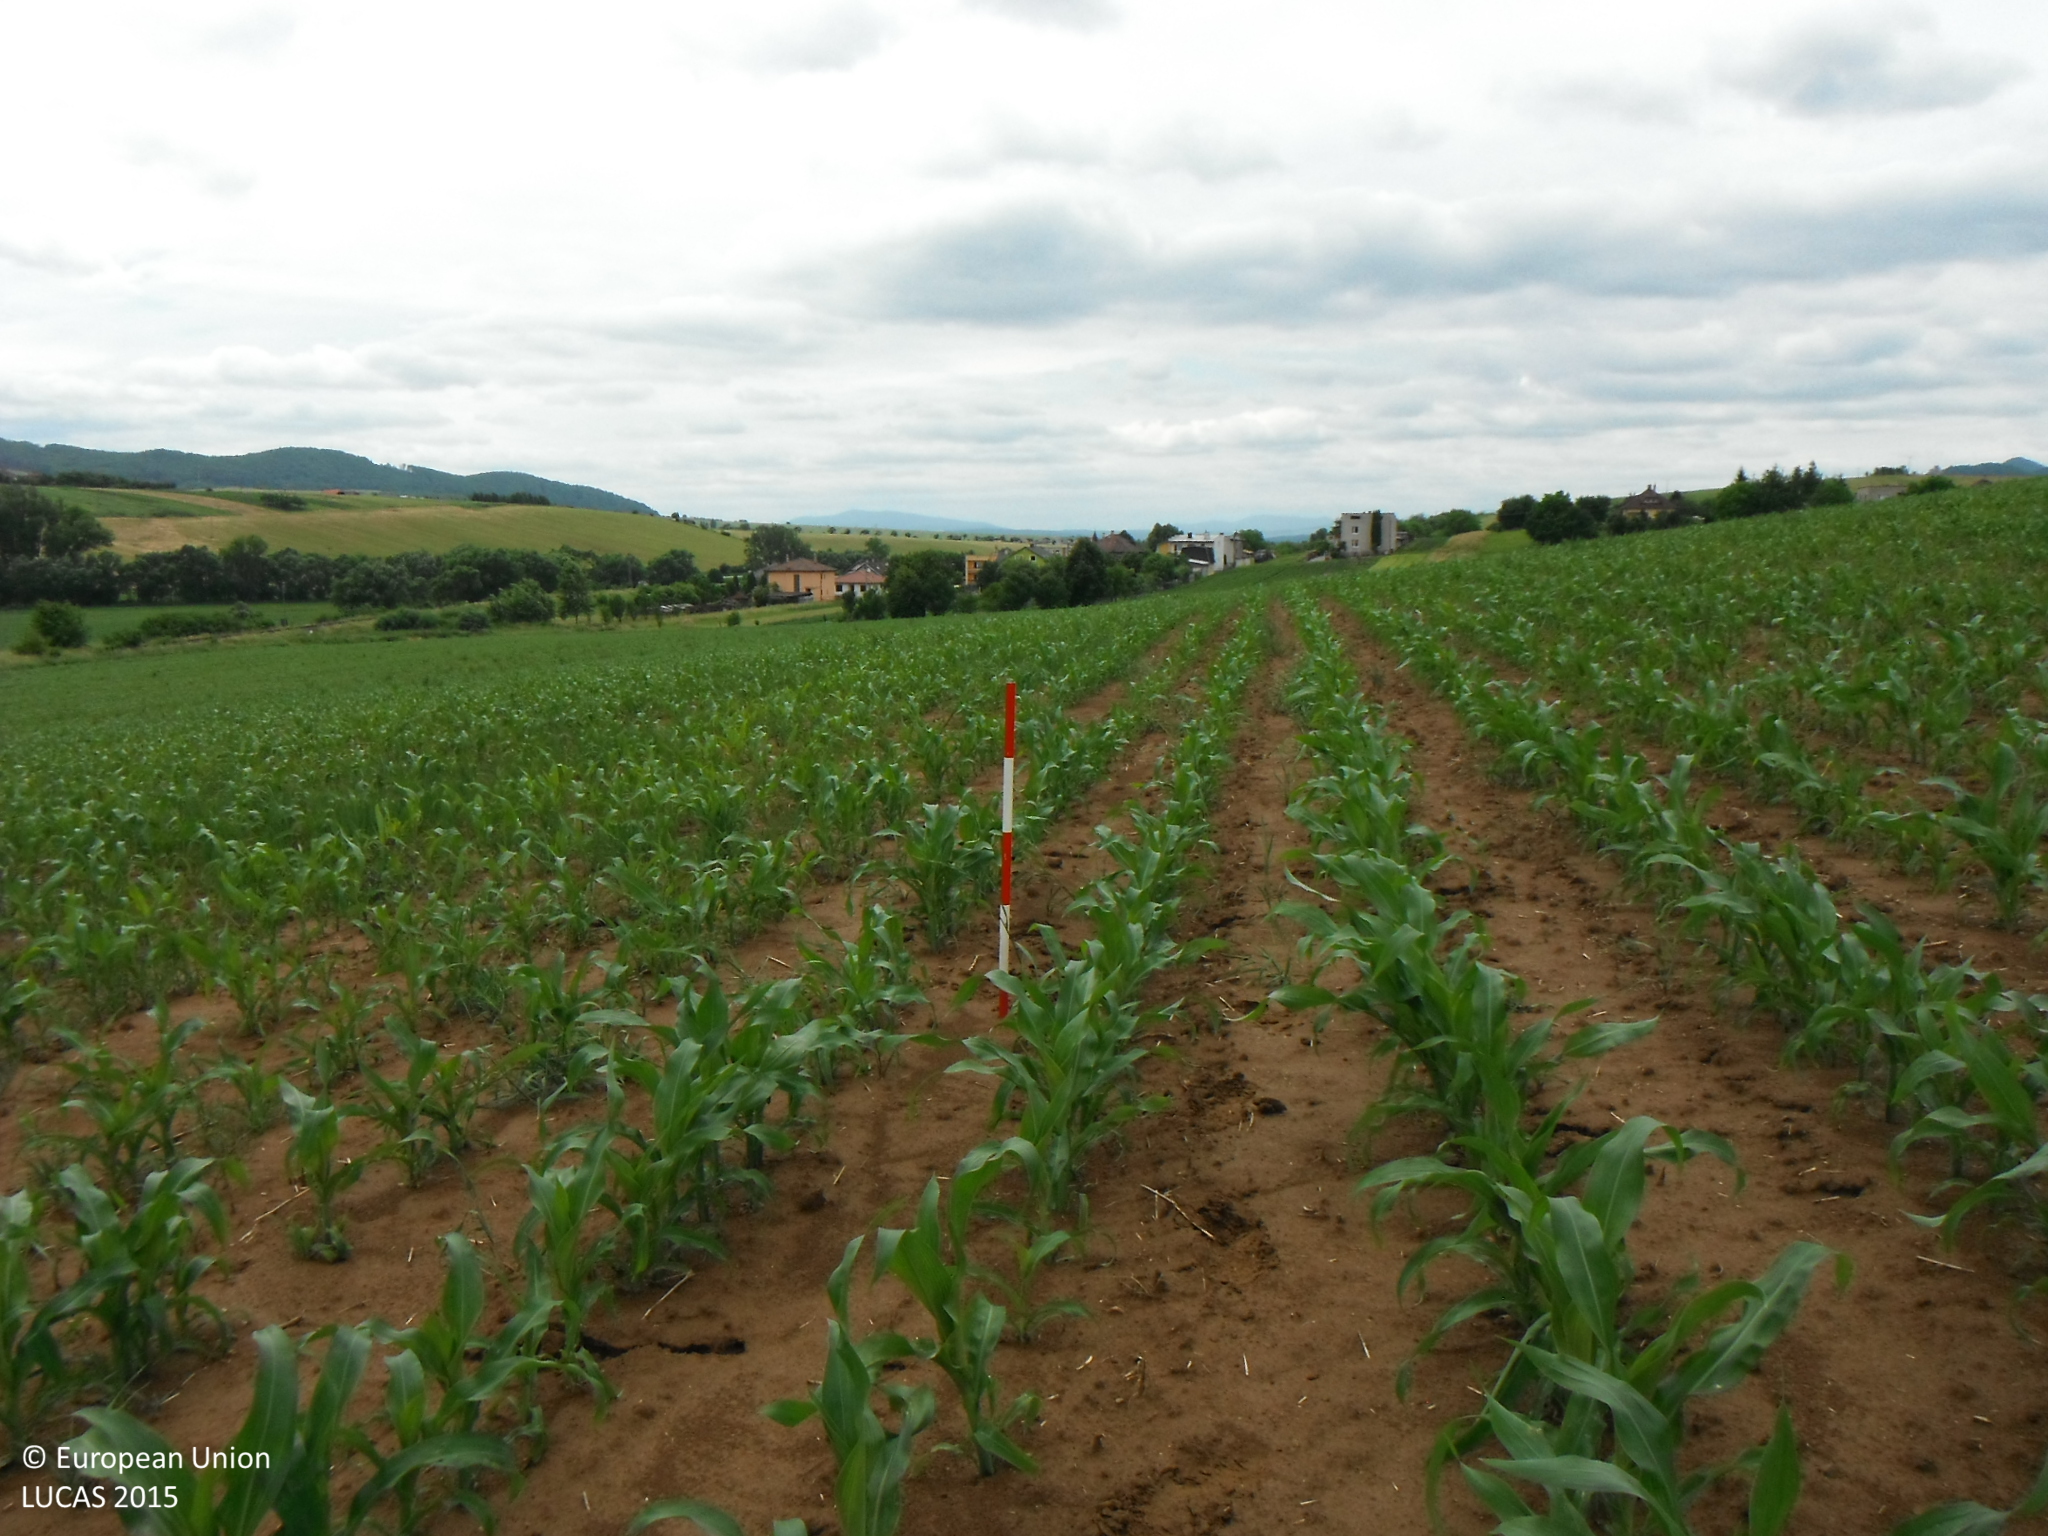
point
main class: Cropland
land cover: Maize
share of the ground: 25 - 50 %
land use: Agriculture (excluding fallow land and kitchen gardens)
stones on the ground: < 10 %
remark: Temporary flooded
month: June
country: SK
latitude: 49.0483
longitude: 21.3895
